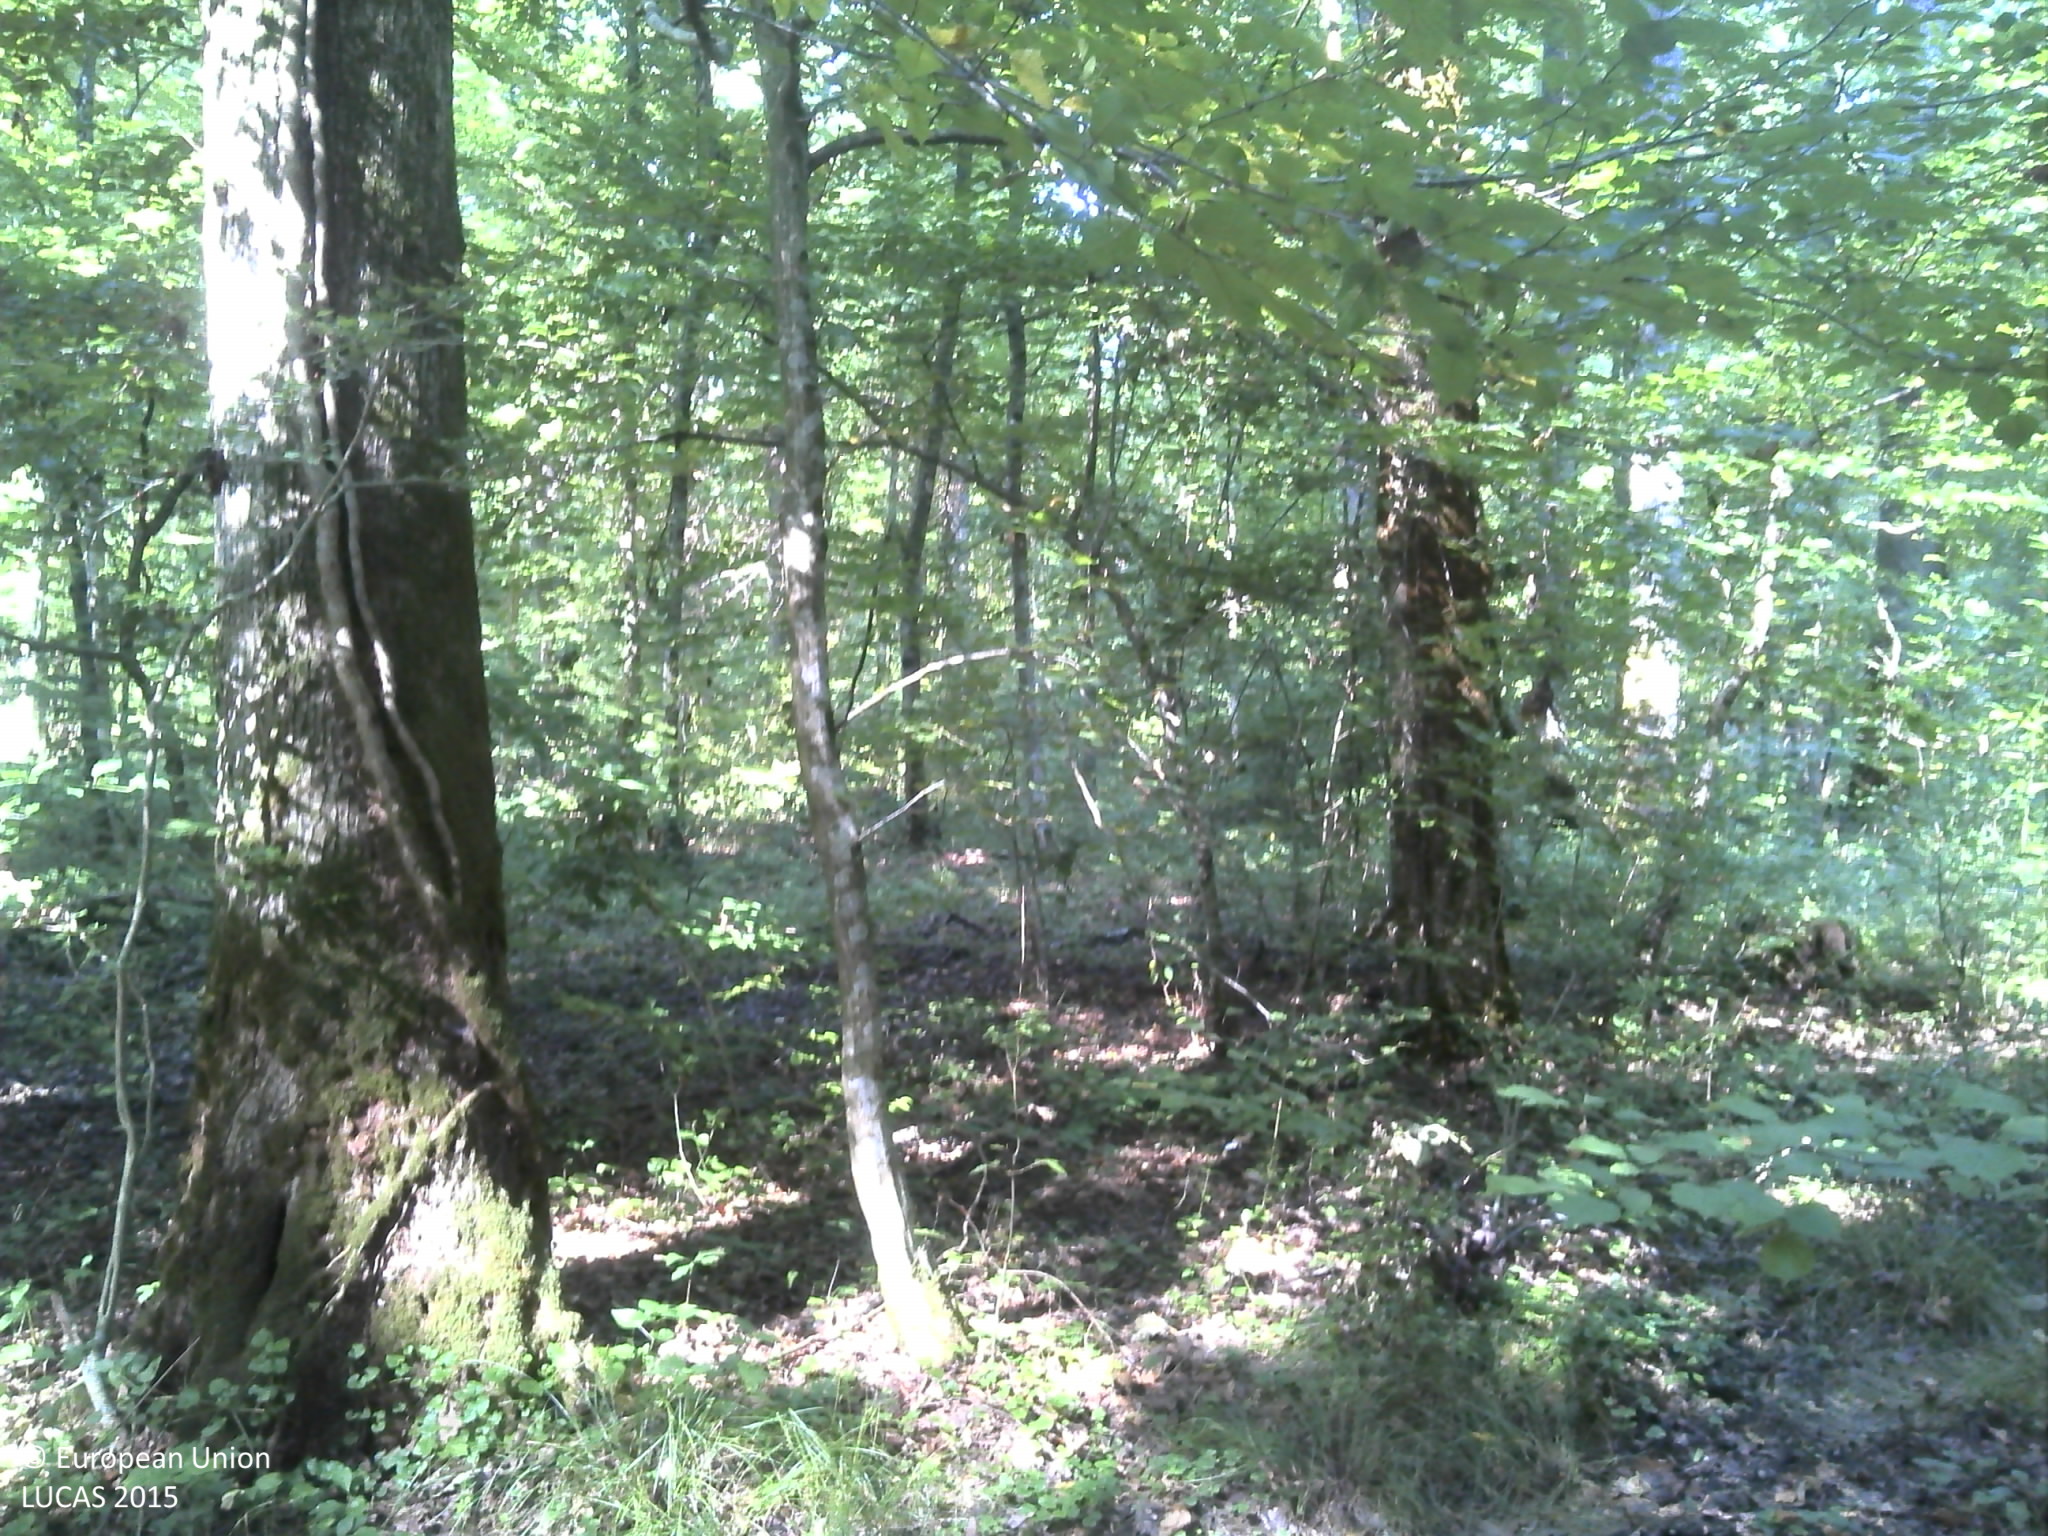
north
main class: Woodland
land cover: Broadleaved woodland
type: acidophilous oak and oak-birch forest
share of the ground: > 75 %
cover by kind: broadleaved forest trees 100 %
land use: Forestry
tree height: > 5 m
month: September
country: HR
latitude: 45.4996
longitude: 16.2556
